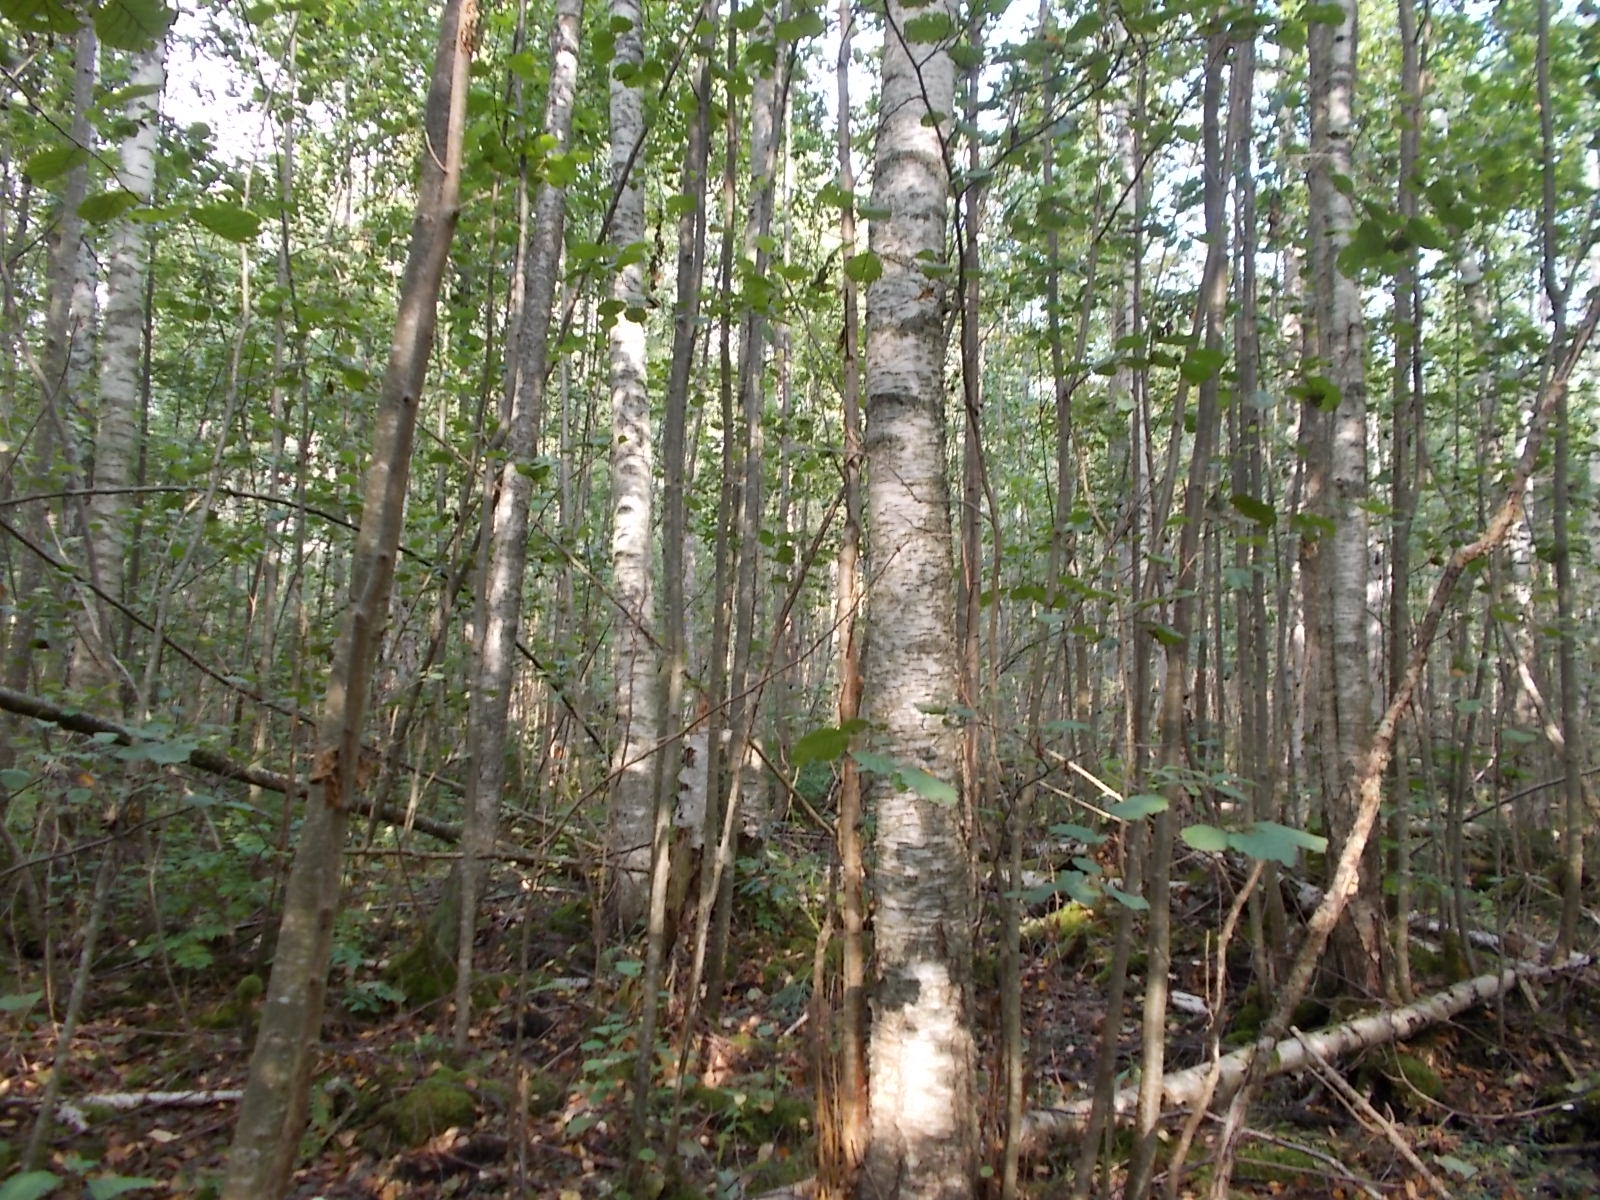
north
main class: Woodland
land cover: Broadleaved woodland
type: mire and swamp forests
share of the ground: > 75 %
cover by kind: broadleaved forest trees 90 %, herbaceous plants 10 %
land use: Forestry
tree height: > 5 m
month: September
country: LV
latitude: 56.9245
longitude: 23.5629
